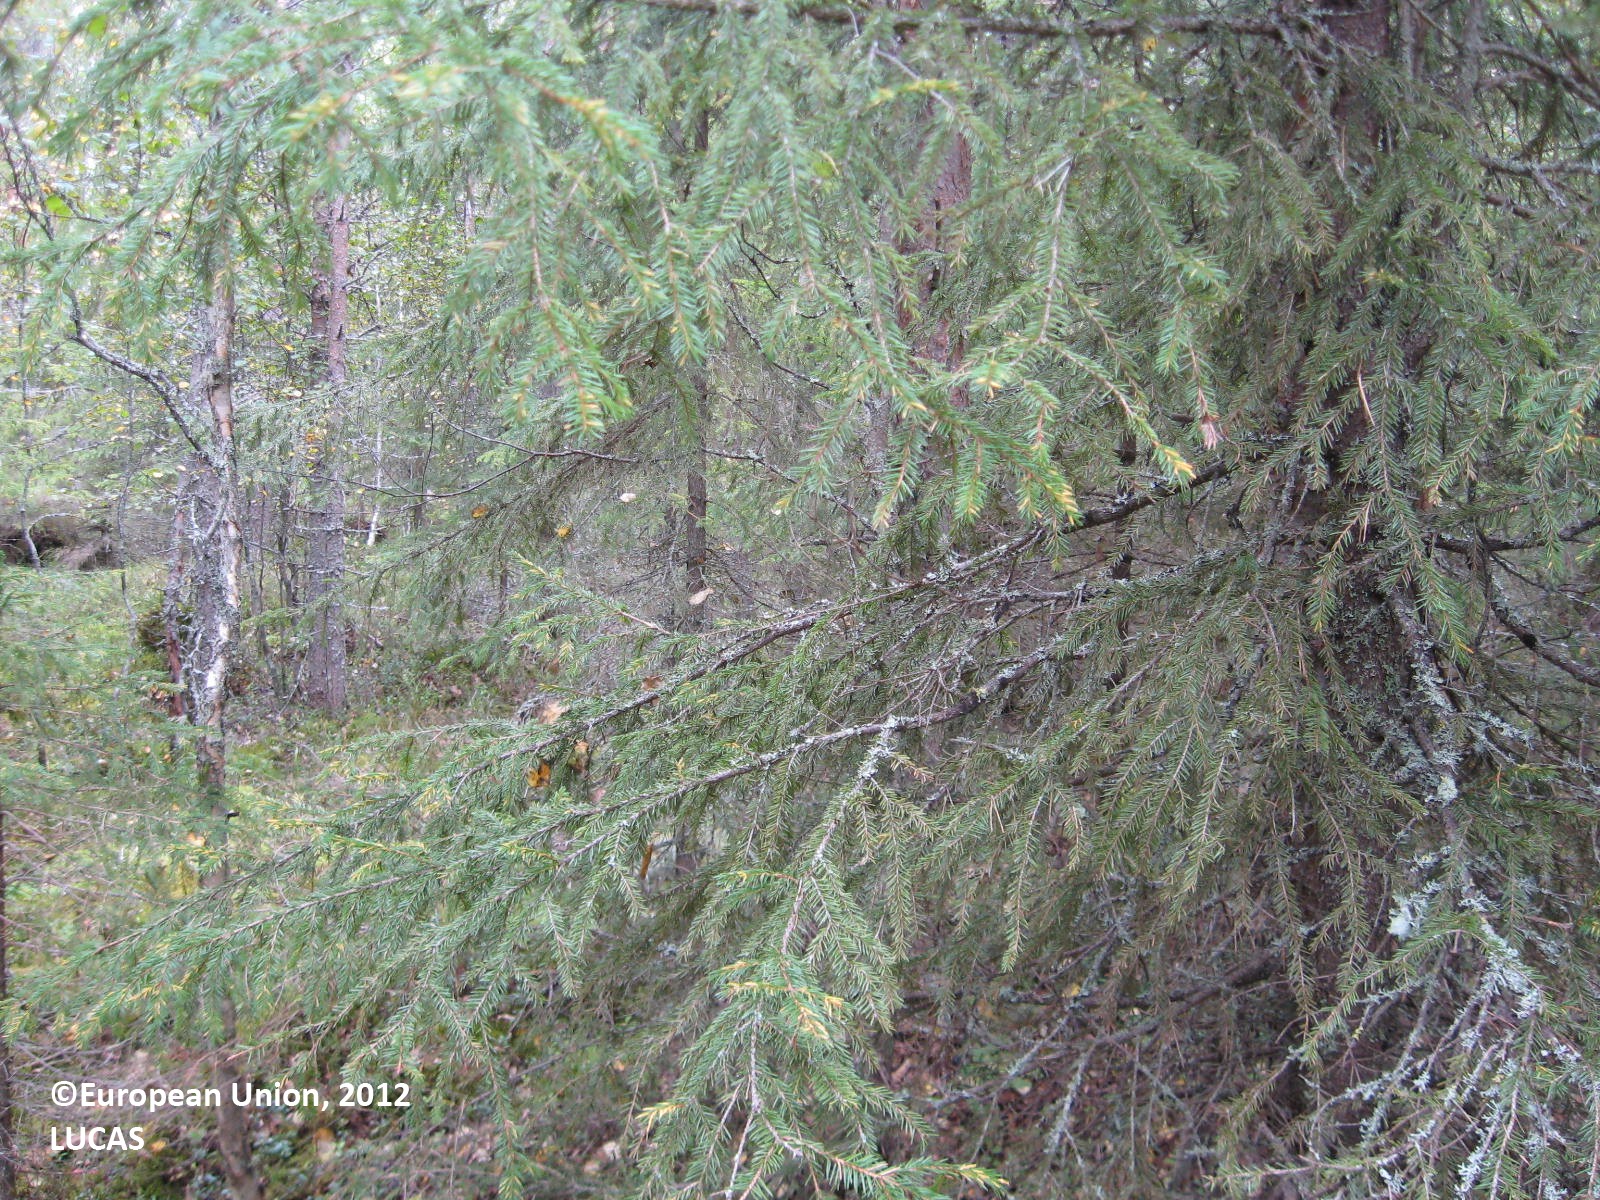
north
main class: Woodland
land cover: Pine dominated mixed woodland
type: boreal forest
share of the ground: > 75 %
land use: Forestry
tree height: > 5 m
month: August
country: FI
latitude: 63.5467
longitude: 30.3215
